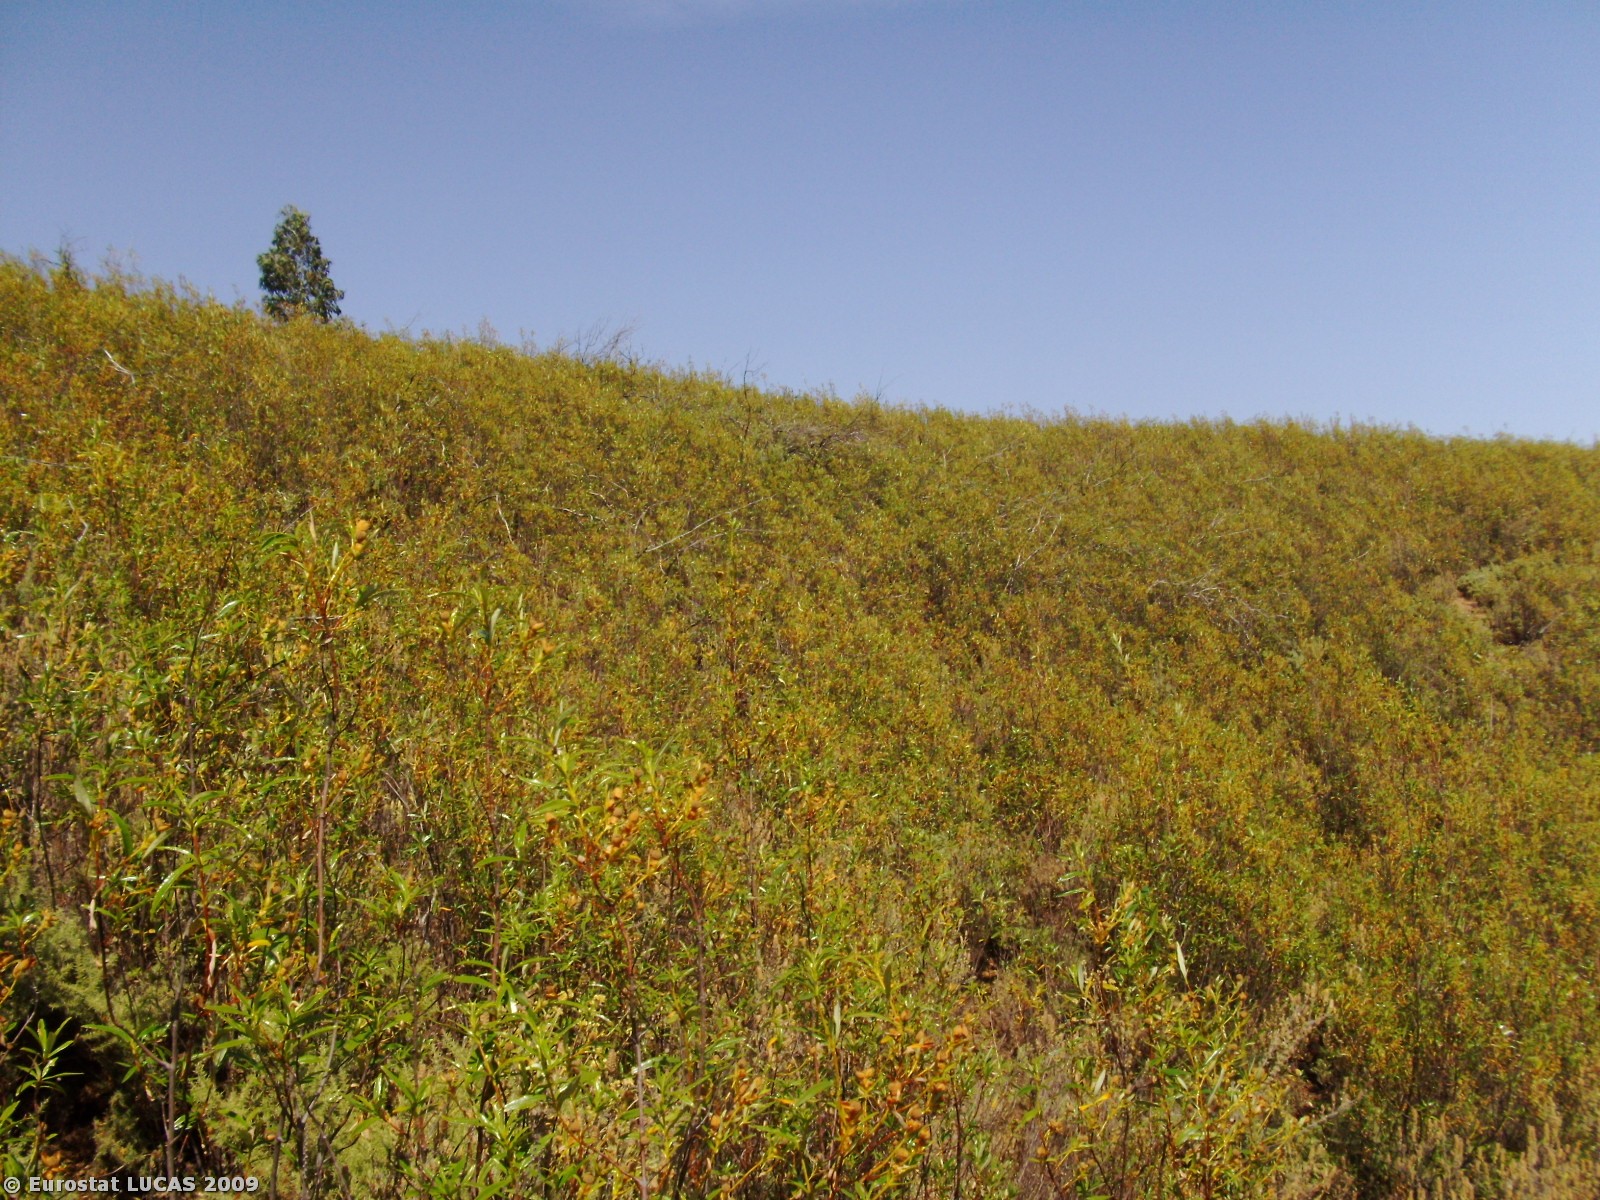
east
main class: Shrubland
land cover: Shrubland without tree cover
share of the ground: > 75 %
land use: Unused
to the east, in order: Shrubland without tree cover; Tracks; Shrubland without tree cover; Other structural elements; Shrubland with sparse tree cover; Tracks; Shrubland with sparse tree cover; Tracks; Shrubland with sparse tree cover; Tracks; Shrubland with sparse tree cover; Tracks; Fences; Lines of trees; Fences; Shrubland with sparse tree cover
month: June
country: PT
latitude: 37.2005
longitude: -8.4687
